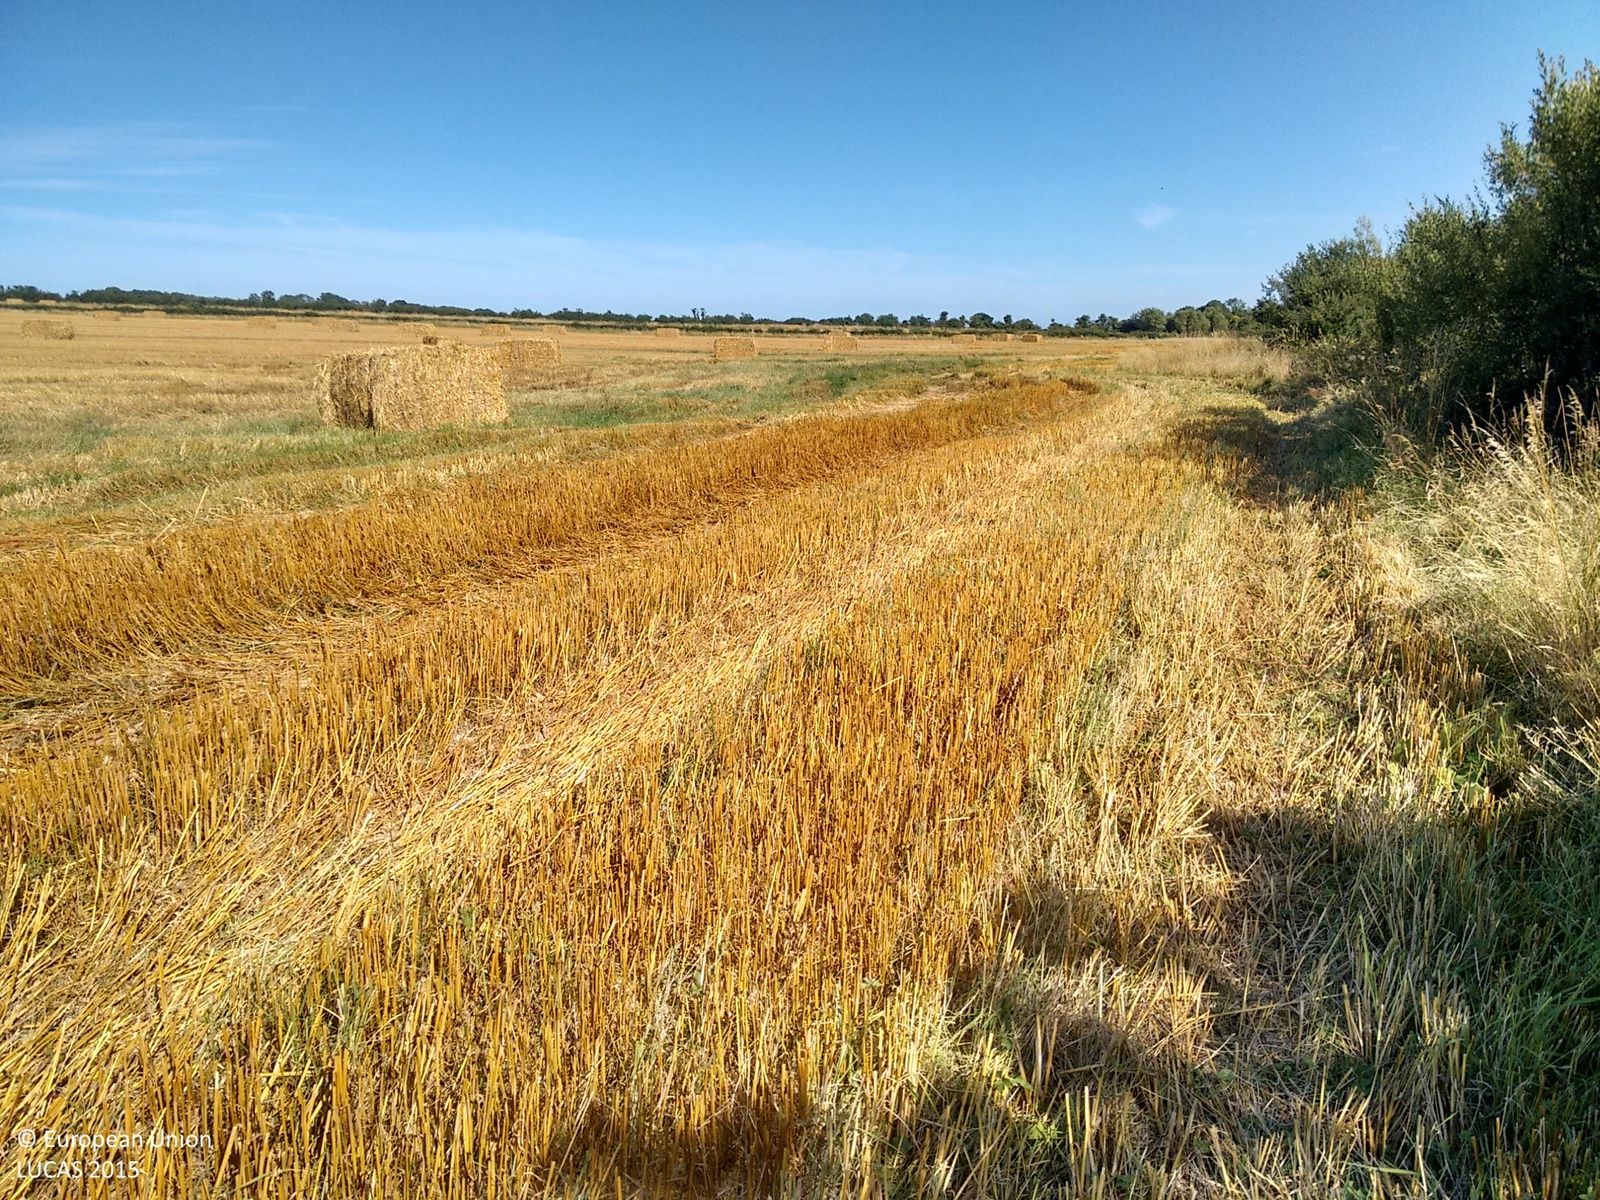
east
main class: Cropland
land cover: Oats
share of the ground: > 75 %
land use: Agriculture (excluding fallow land and kitchen gardens)
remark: Harvested field
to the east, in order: Oats; Grass margins; Managed hedges; Grass margins; Oats
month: August
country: IE
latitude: 53.8509
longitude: -6.2785
